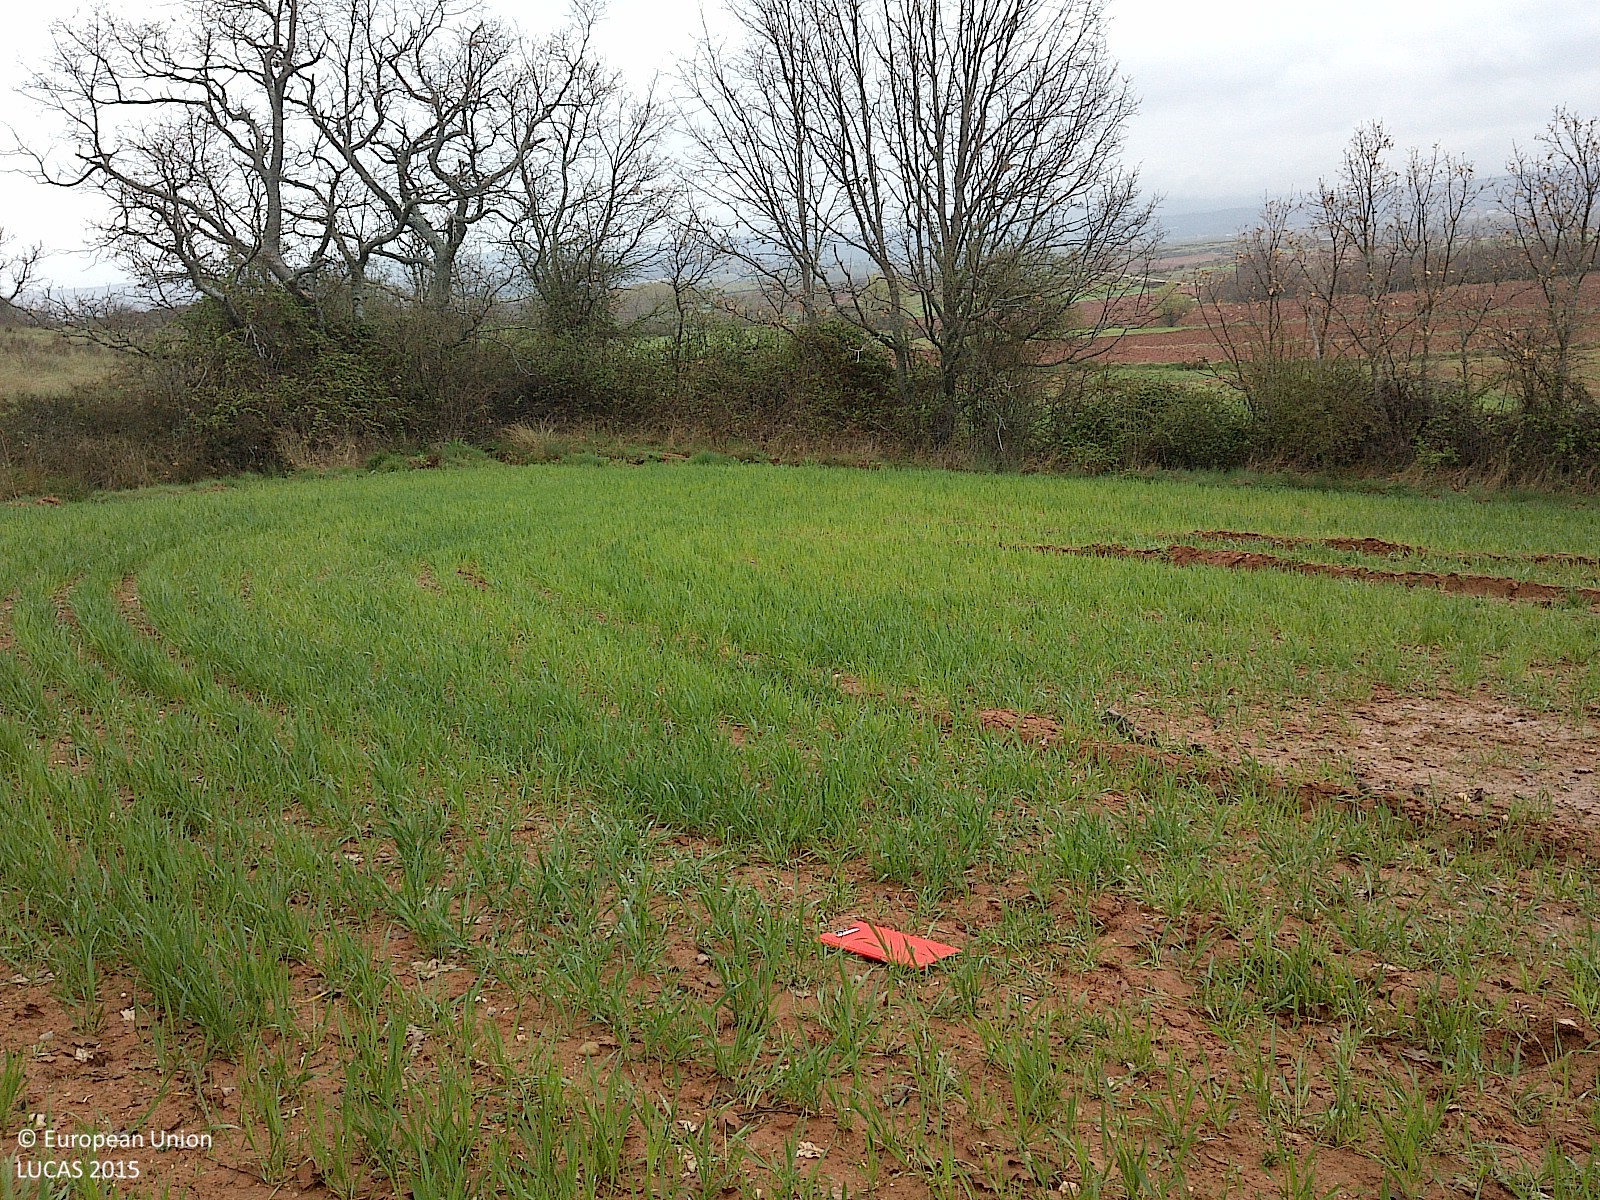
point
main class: Cropland
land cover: Barley
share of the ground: 50 - 75 %
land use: Agriculture (excluding fallow land and kitchen gardens)
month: April
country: ES
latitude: 41.9897
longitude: -3.3170
